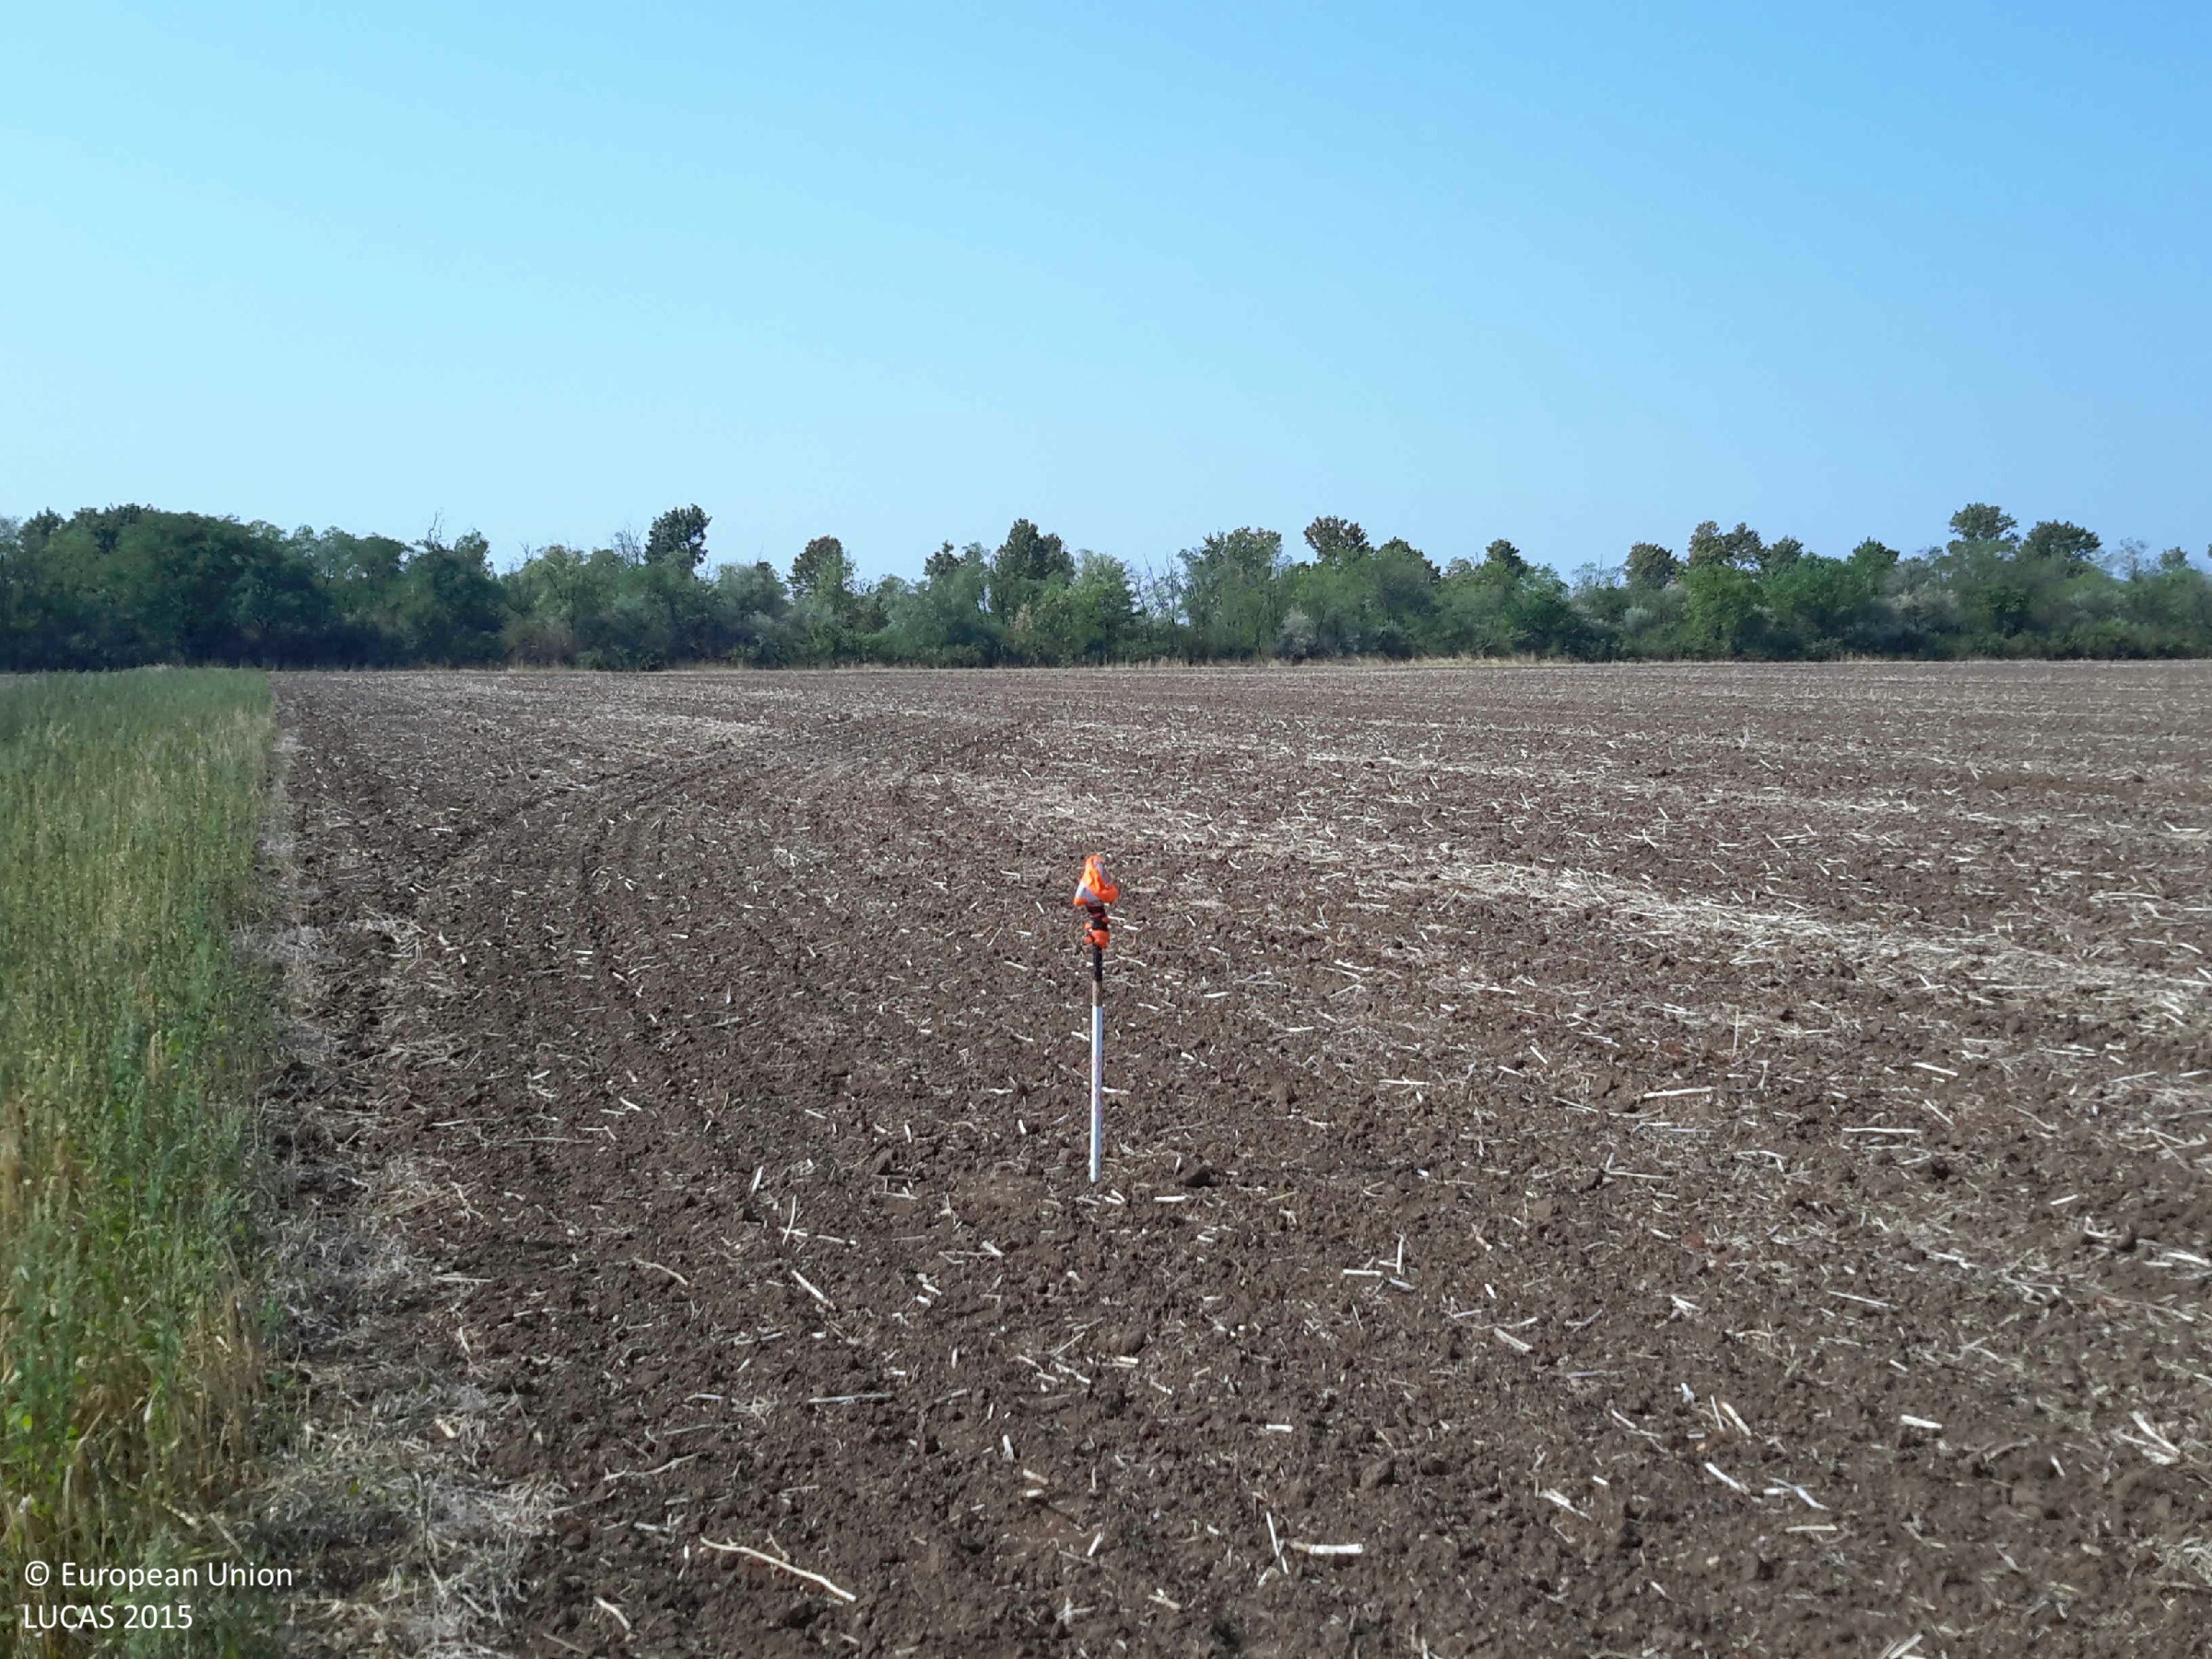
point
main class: Cropland
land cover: Rape and turnip rape
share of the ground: < 10 %
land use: Agriculture (excluding fallow land and kitchen gardens)
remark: Harvested field
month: August
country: HU
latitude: 47.8659
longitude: 17.1325
